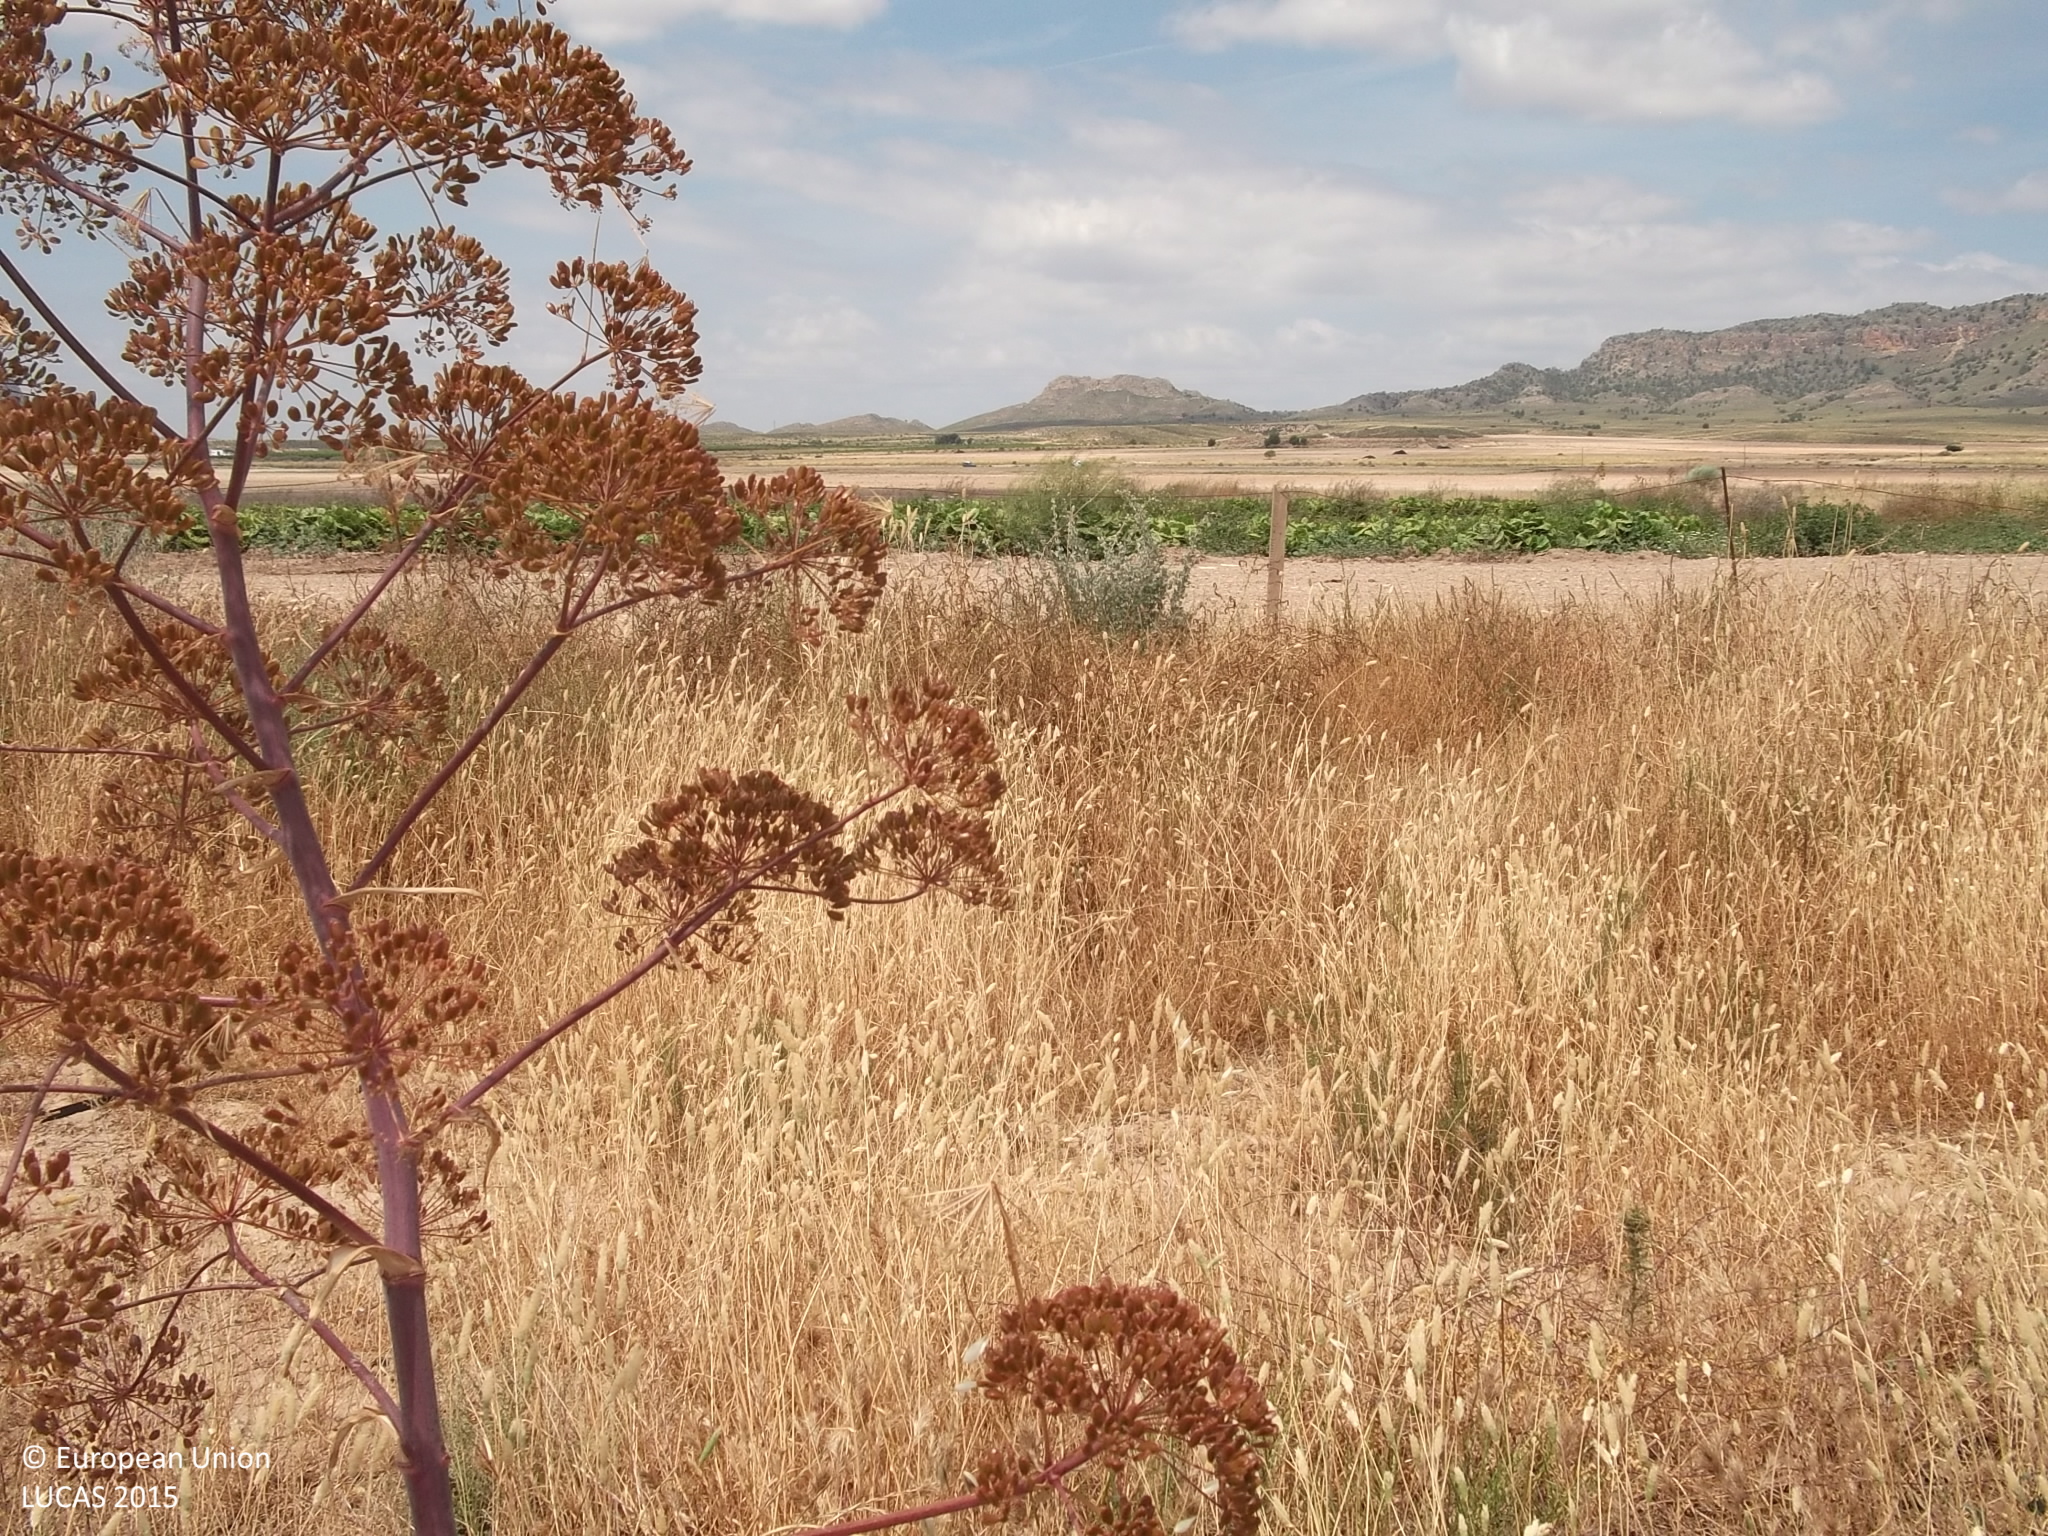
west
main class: Shrubland
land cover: Shrubland without tree cover
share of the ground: 10 - 25 %
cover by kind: herbaceous plants 40 %, consolidated bare surface 40 %, shrubs 20 %
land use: Semi-natural and natural areas not in use
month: May
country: ES
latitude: 38.3530
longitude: -1.4445
